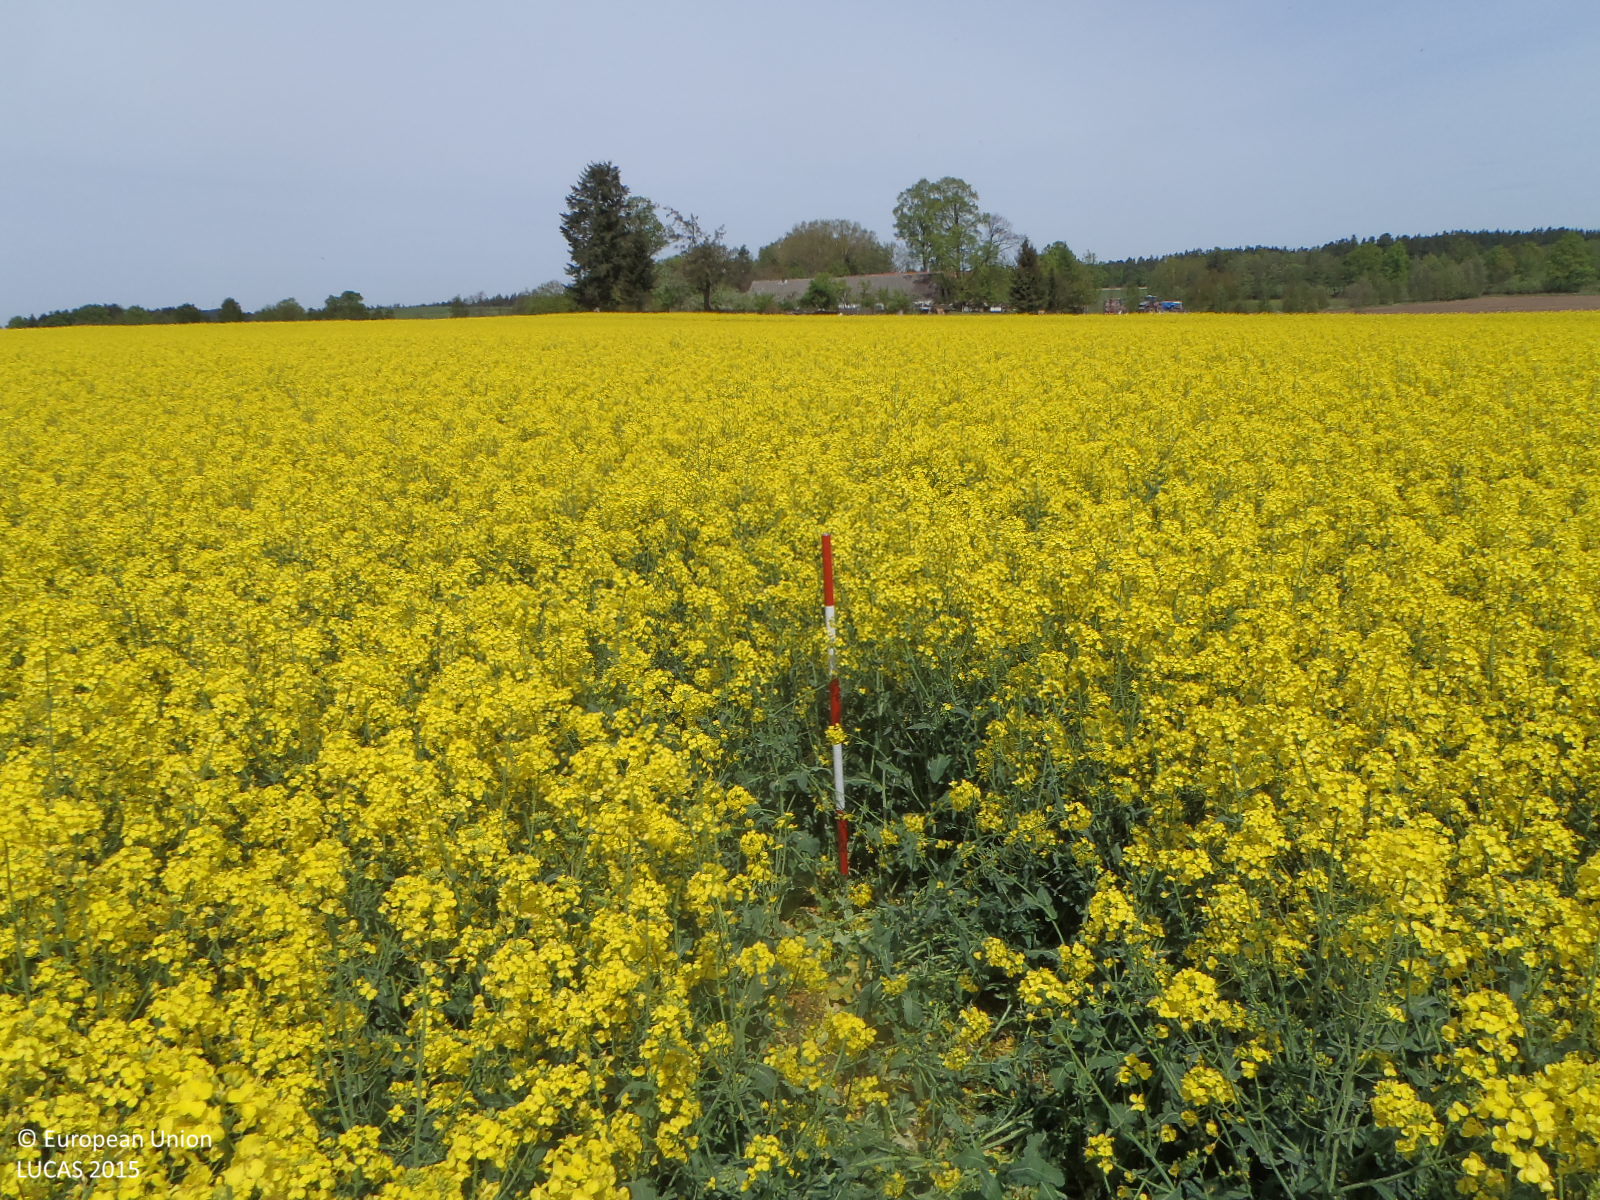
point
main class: Cropland
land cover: Rape and turnip rape
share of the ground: > 75 %
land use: Agriculture (excluding fallow land and kitchen gardens)
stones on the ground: < 10 %
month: May
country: CZ
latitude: 49.1960
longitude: 14.9011
